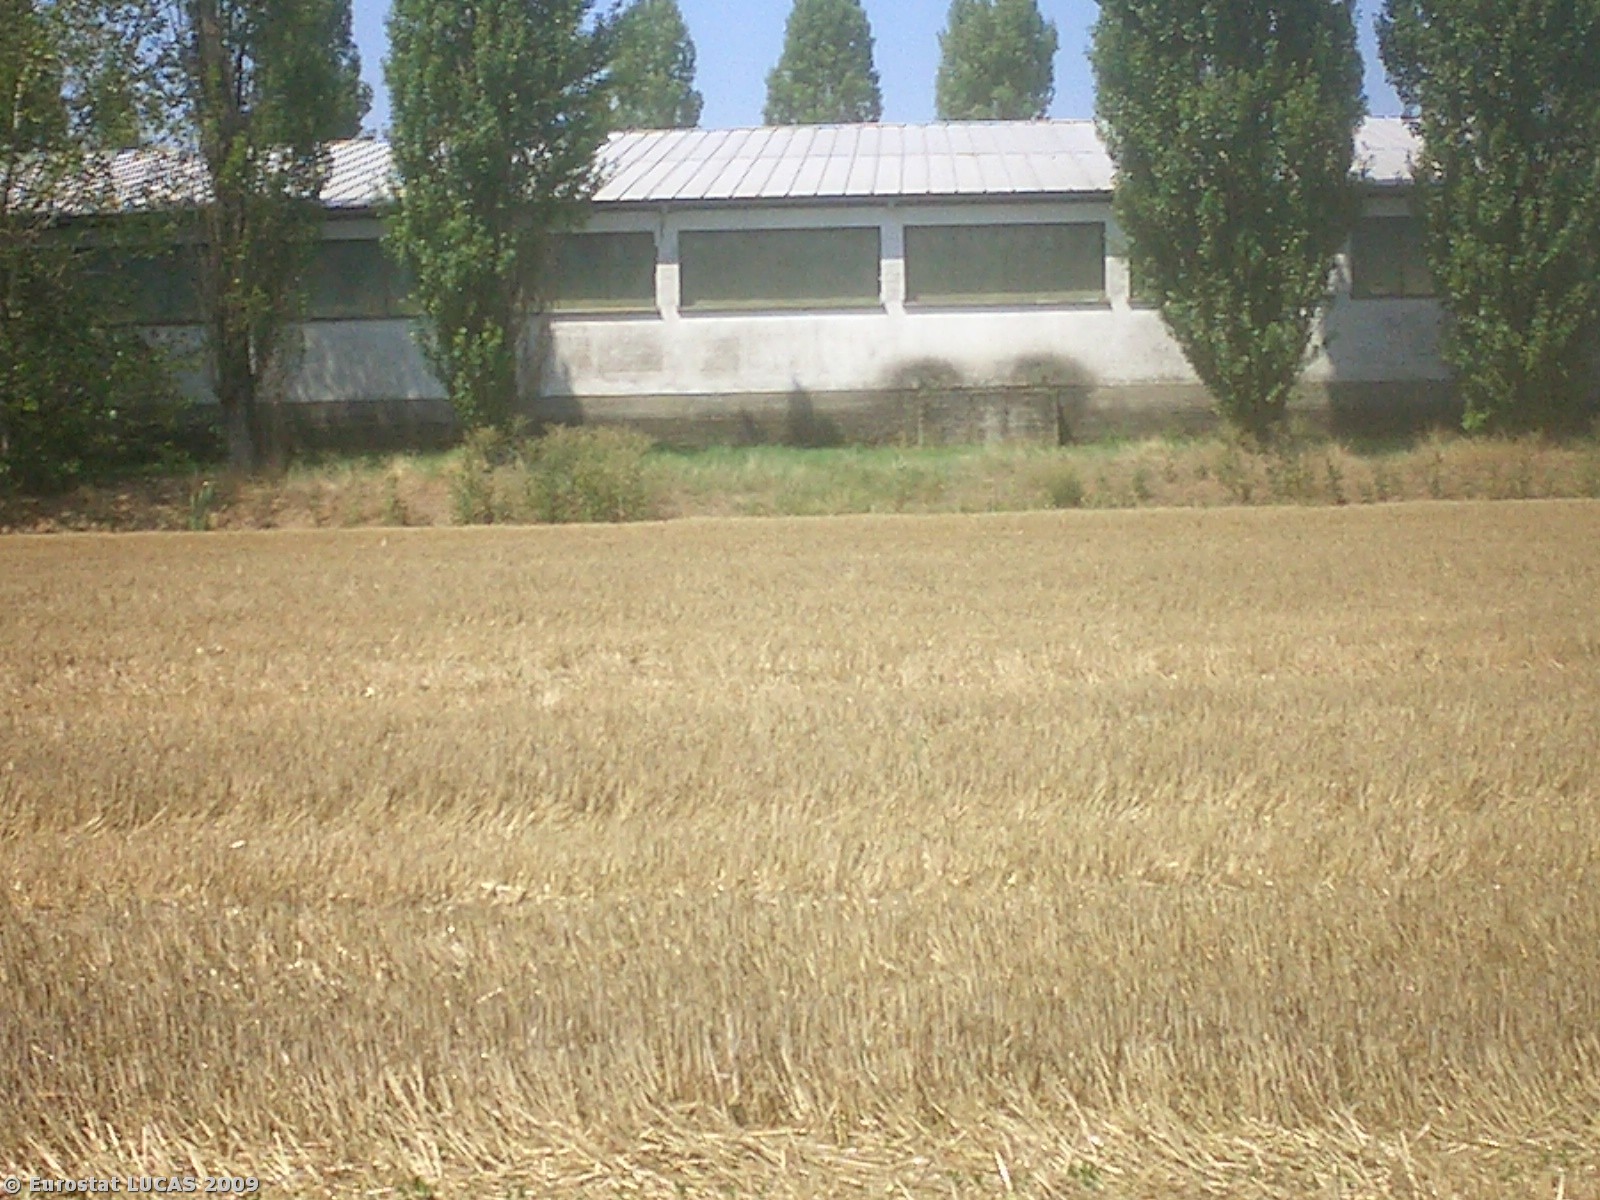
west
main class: Cropland
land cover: Soya
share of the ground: < 10 %
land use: Agriculture (excluding fallow land and kitchen gardens)
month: July
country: IT
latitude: 44.8898
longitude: 12.0347
